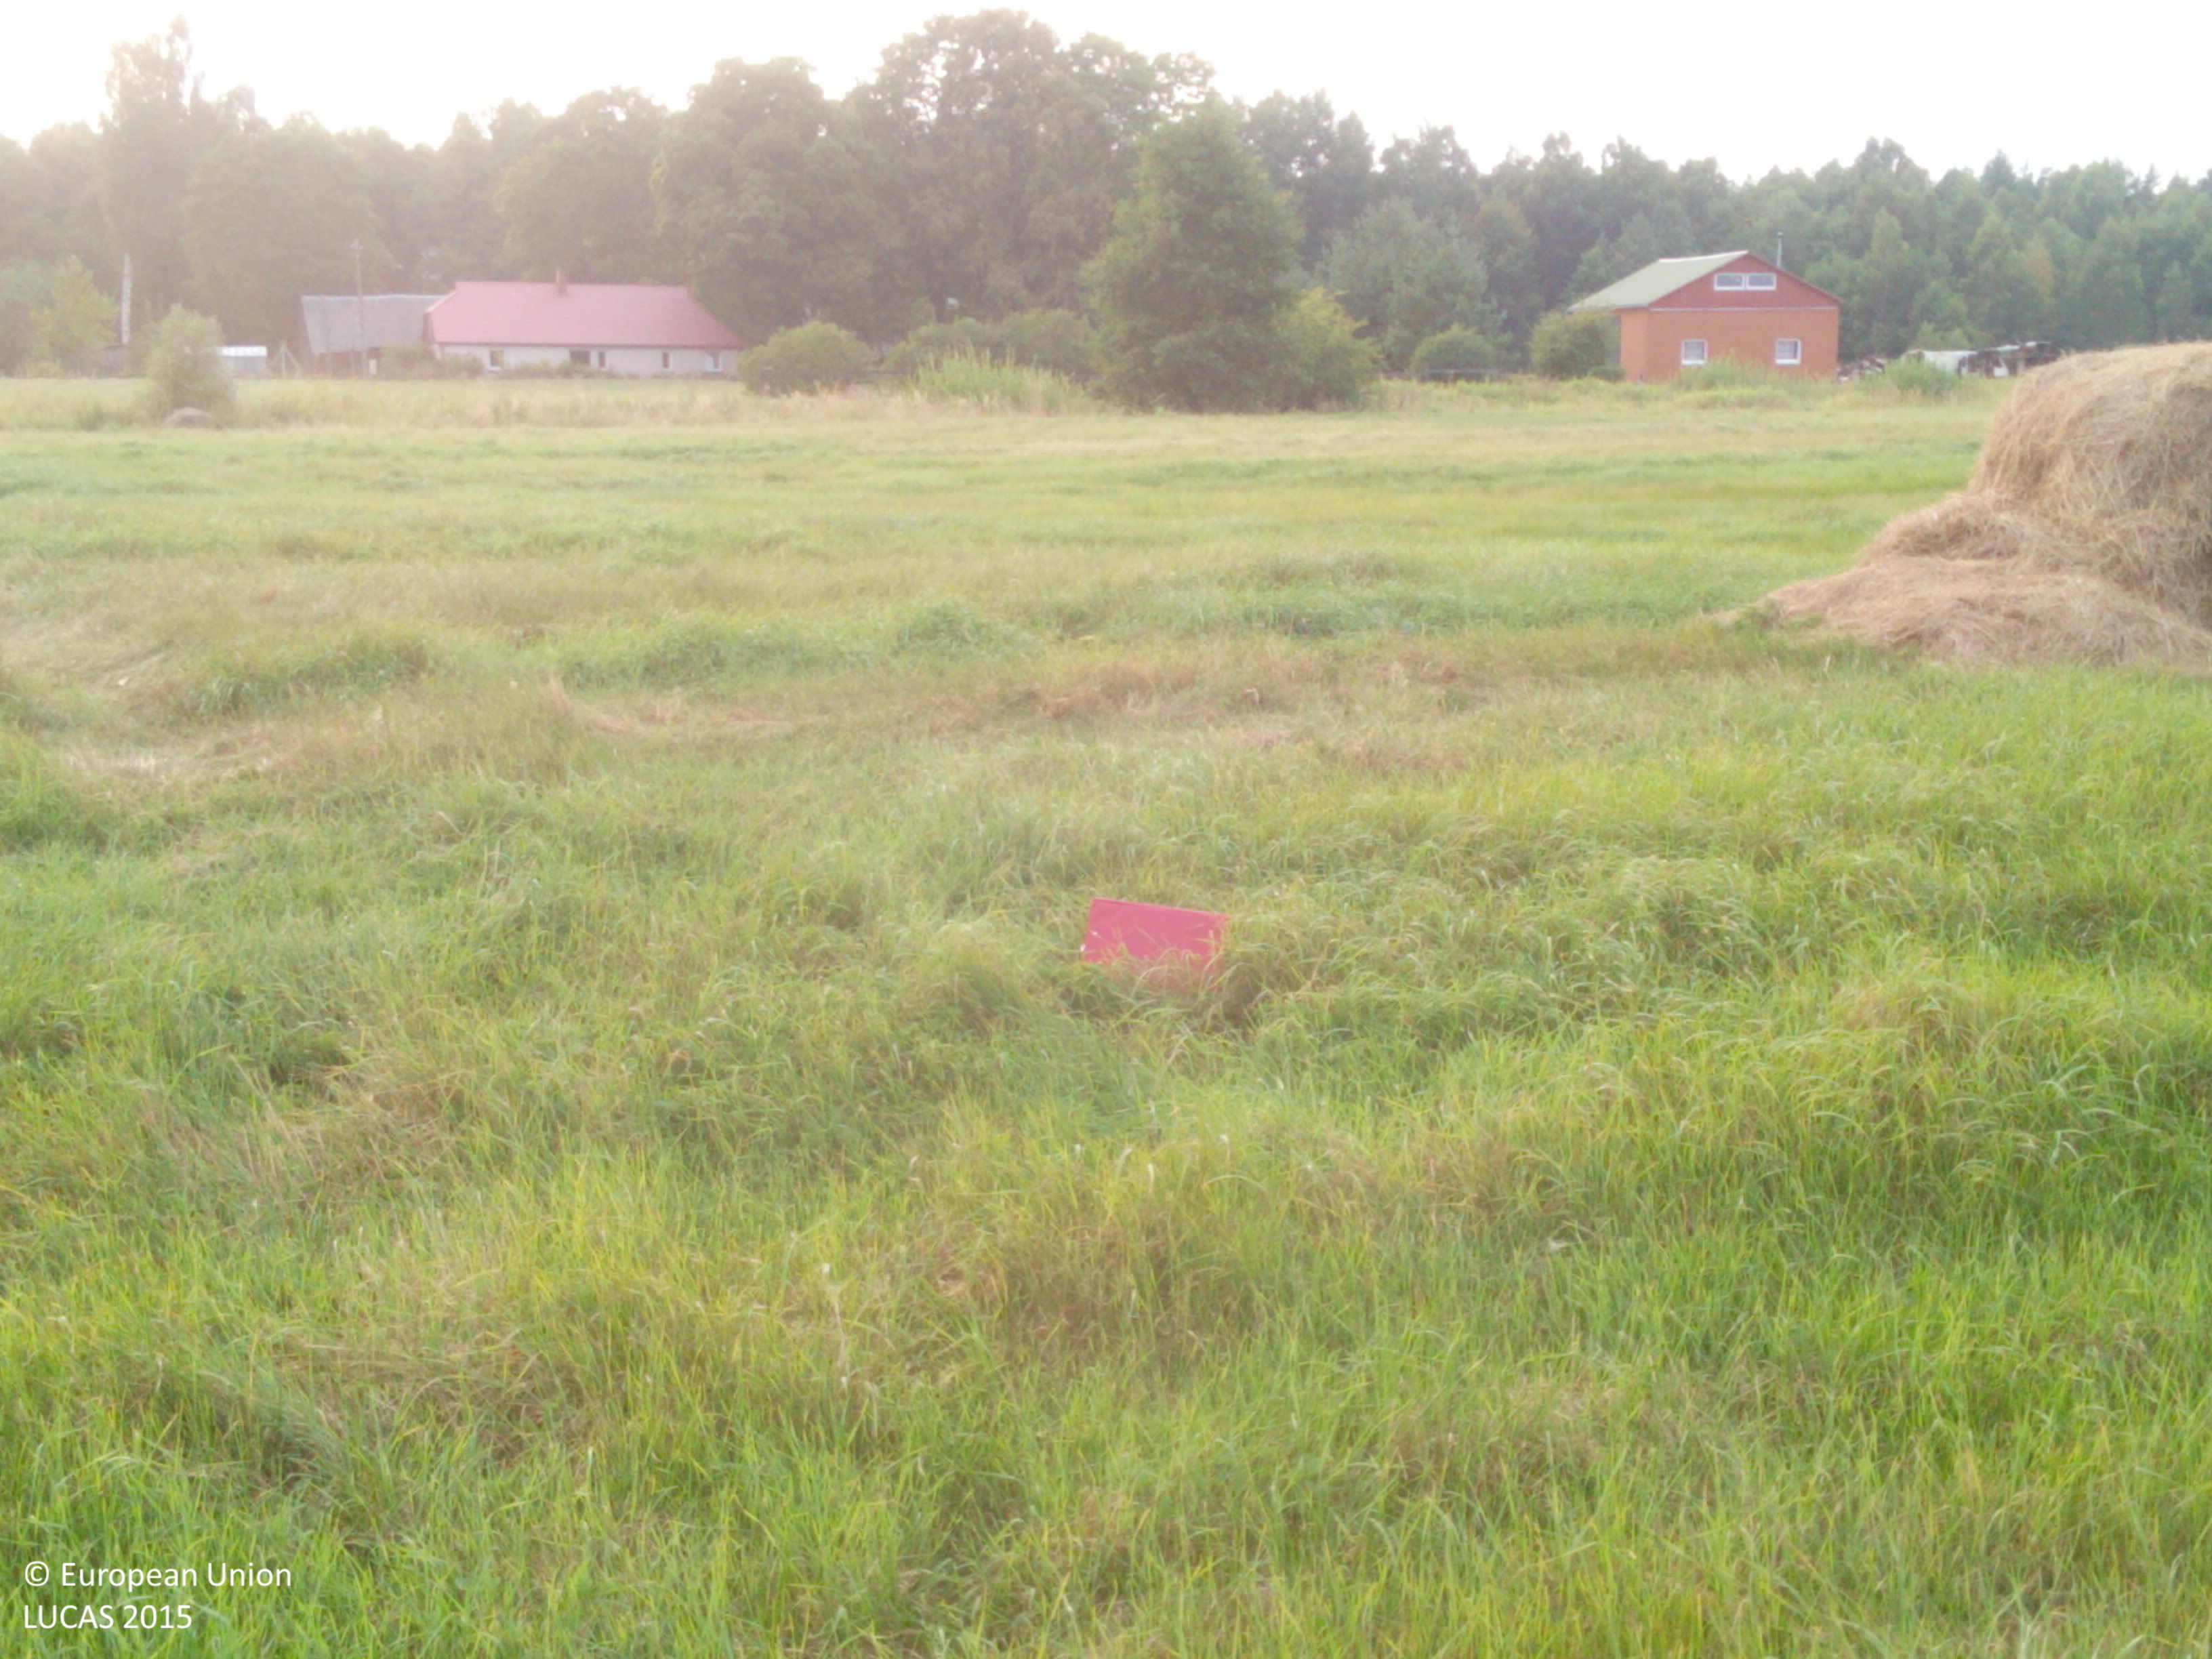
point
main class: Grassland
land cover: Grassland without tree/shrub cover
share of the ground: > 75 %
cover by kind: herbaceous plants 100 %
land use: Agriculture (excluding fallow land and kitchen gardens)
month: August
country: LV
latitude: 56.1355
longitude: 21.1581
